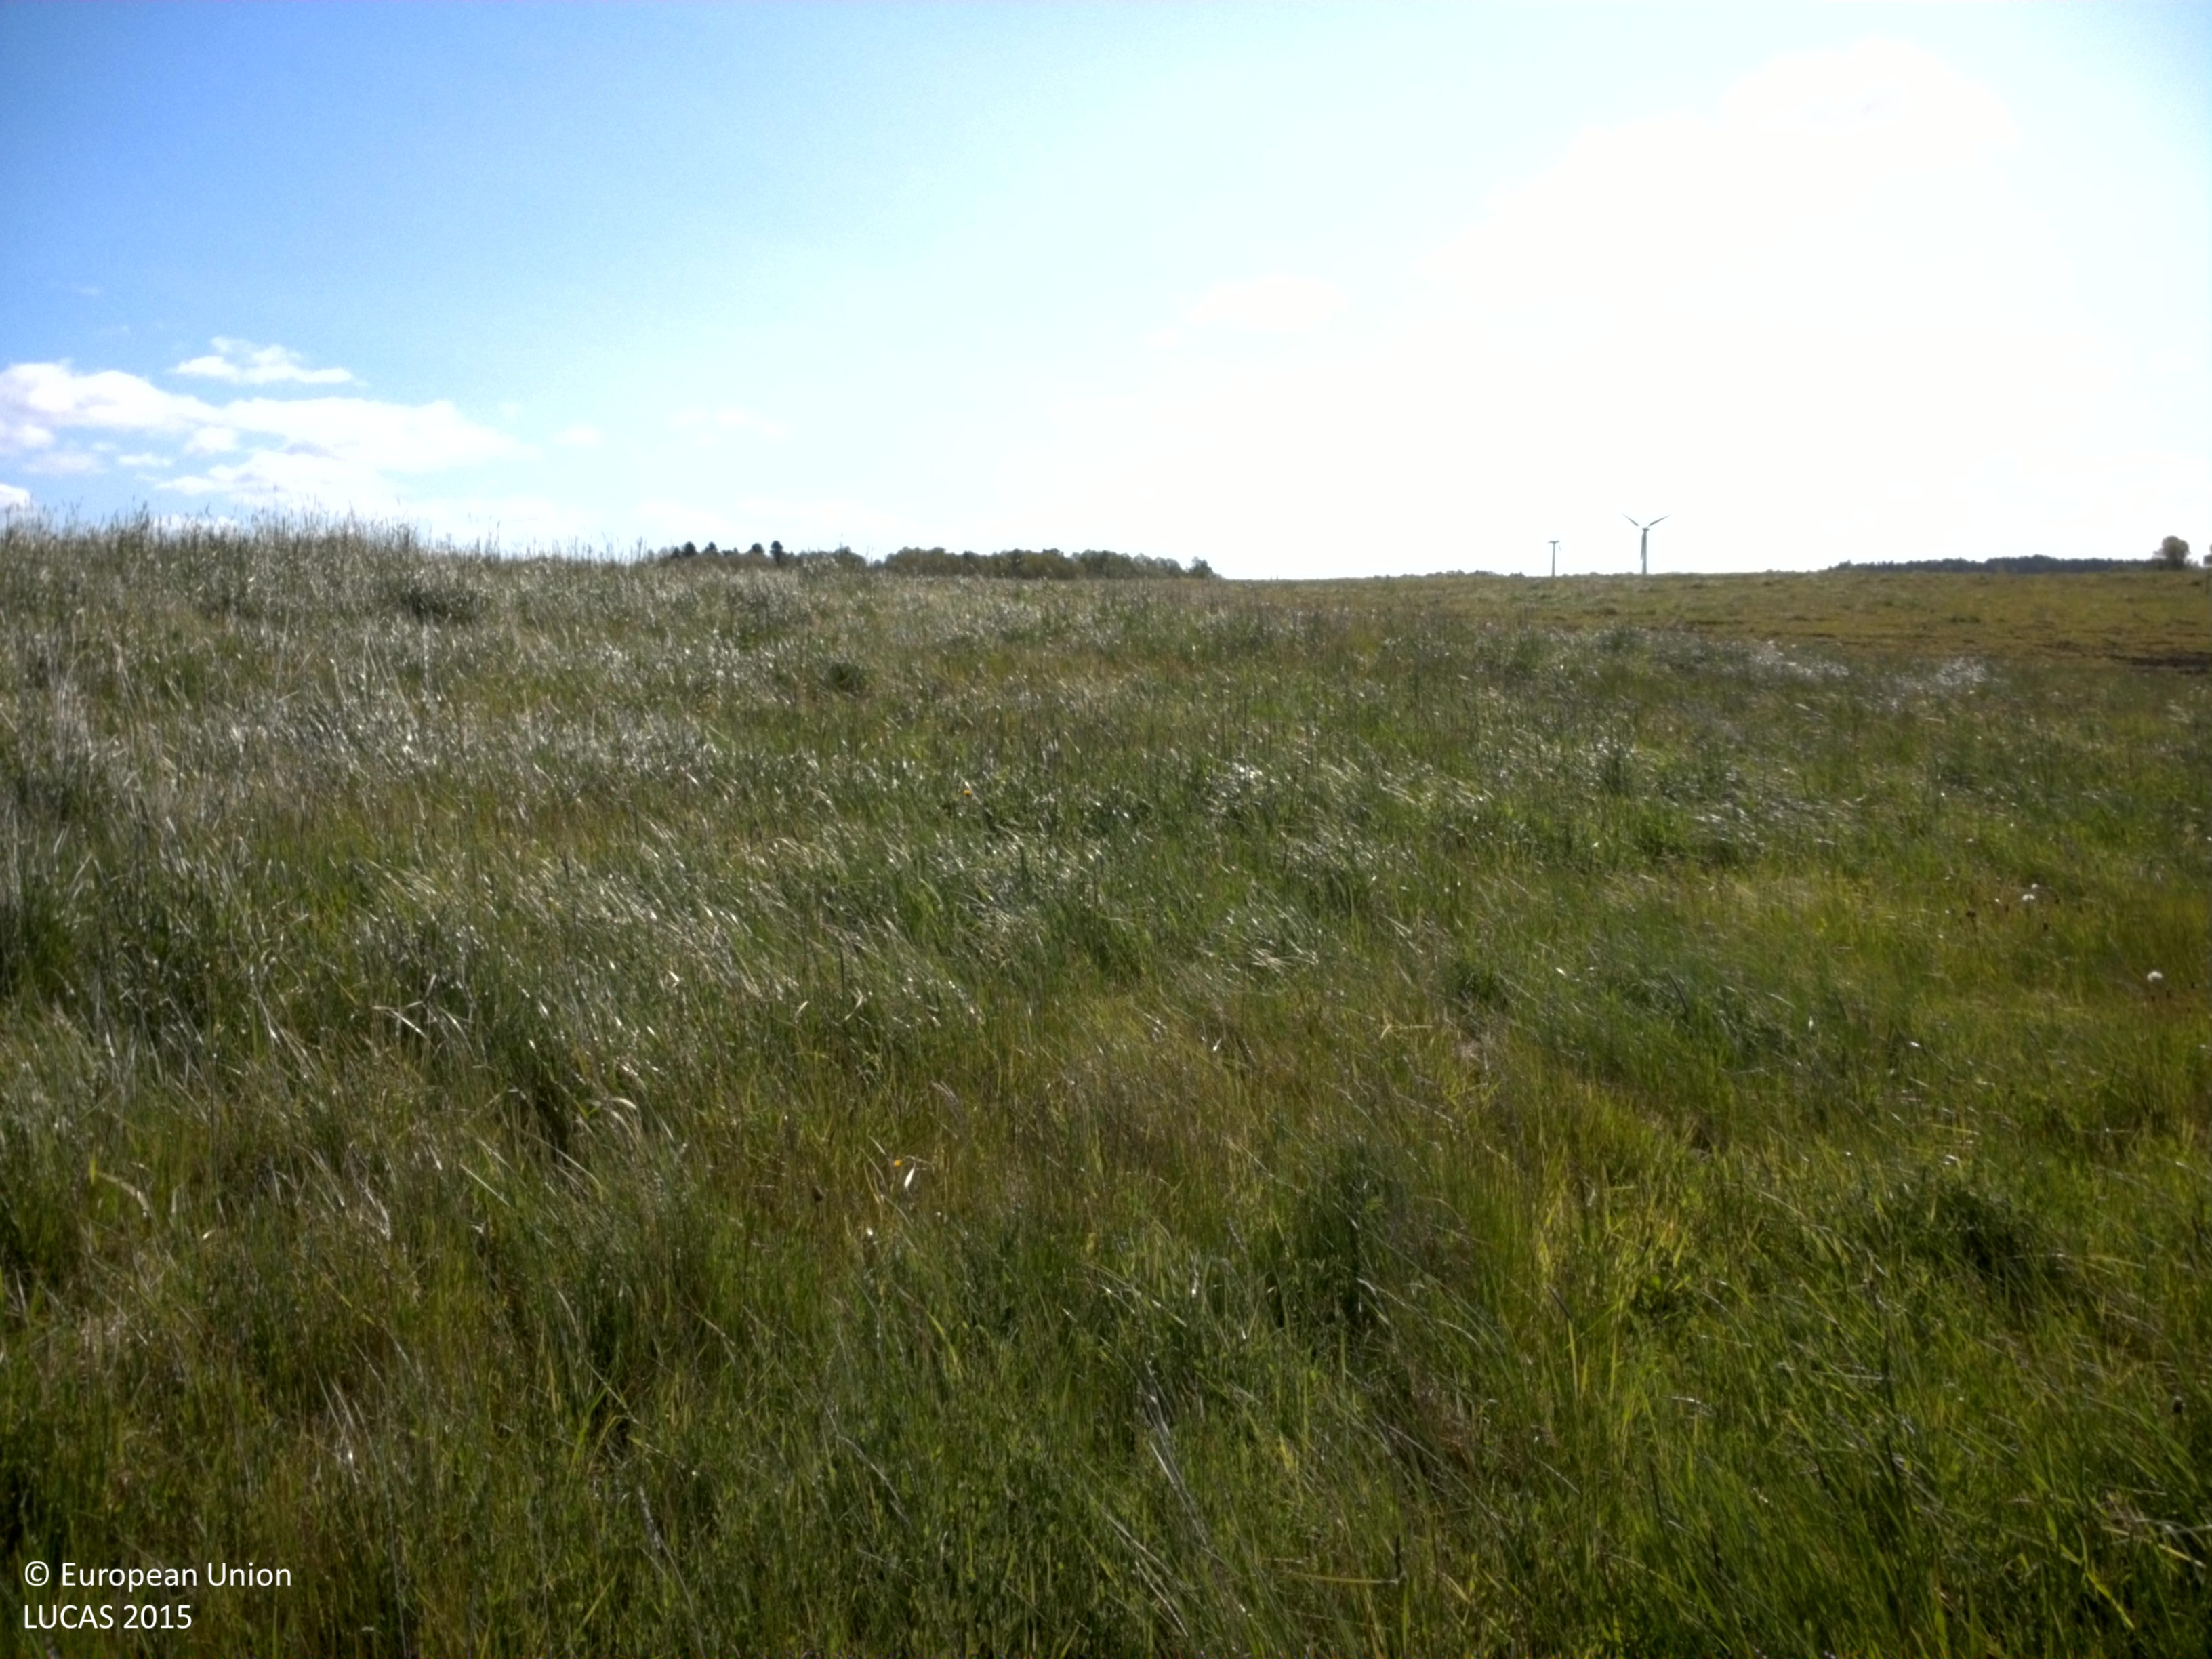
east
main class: Grassland
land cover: Grassland without tree/shrub cover
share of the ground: > 75 %
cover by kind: herbaceous plants 100 %
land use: Community services
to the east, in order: Grassland without tree/shrub cover; Paved roads, cycling and walking lanes; Grassland without tree/shrub cover
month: June
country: SE
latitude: 58.3429
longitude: 13.9059
